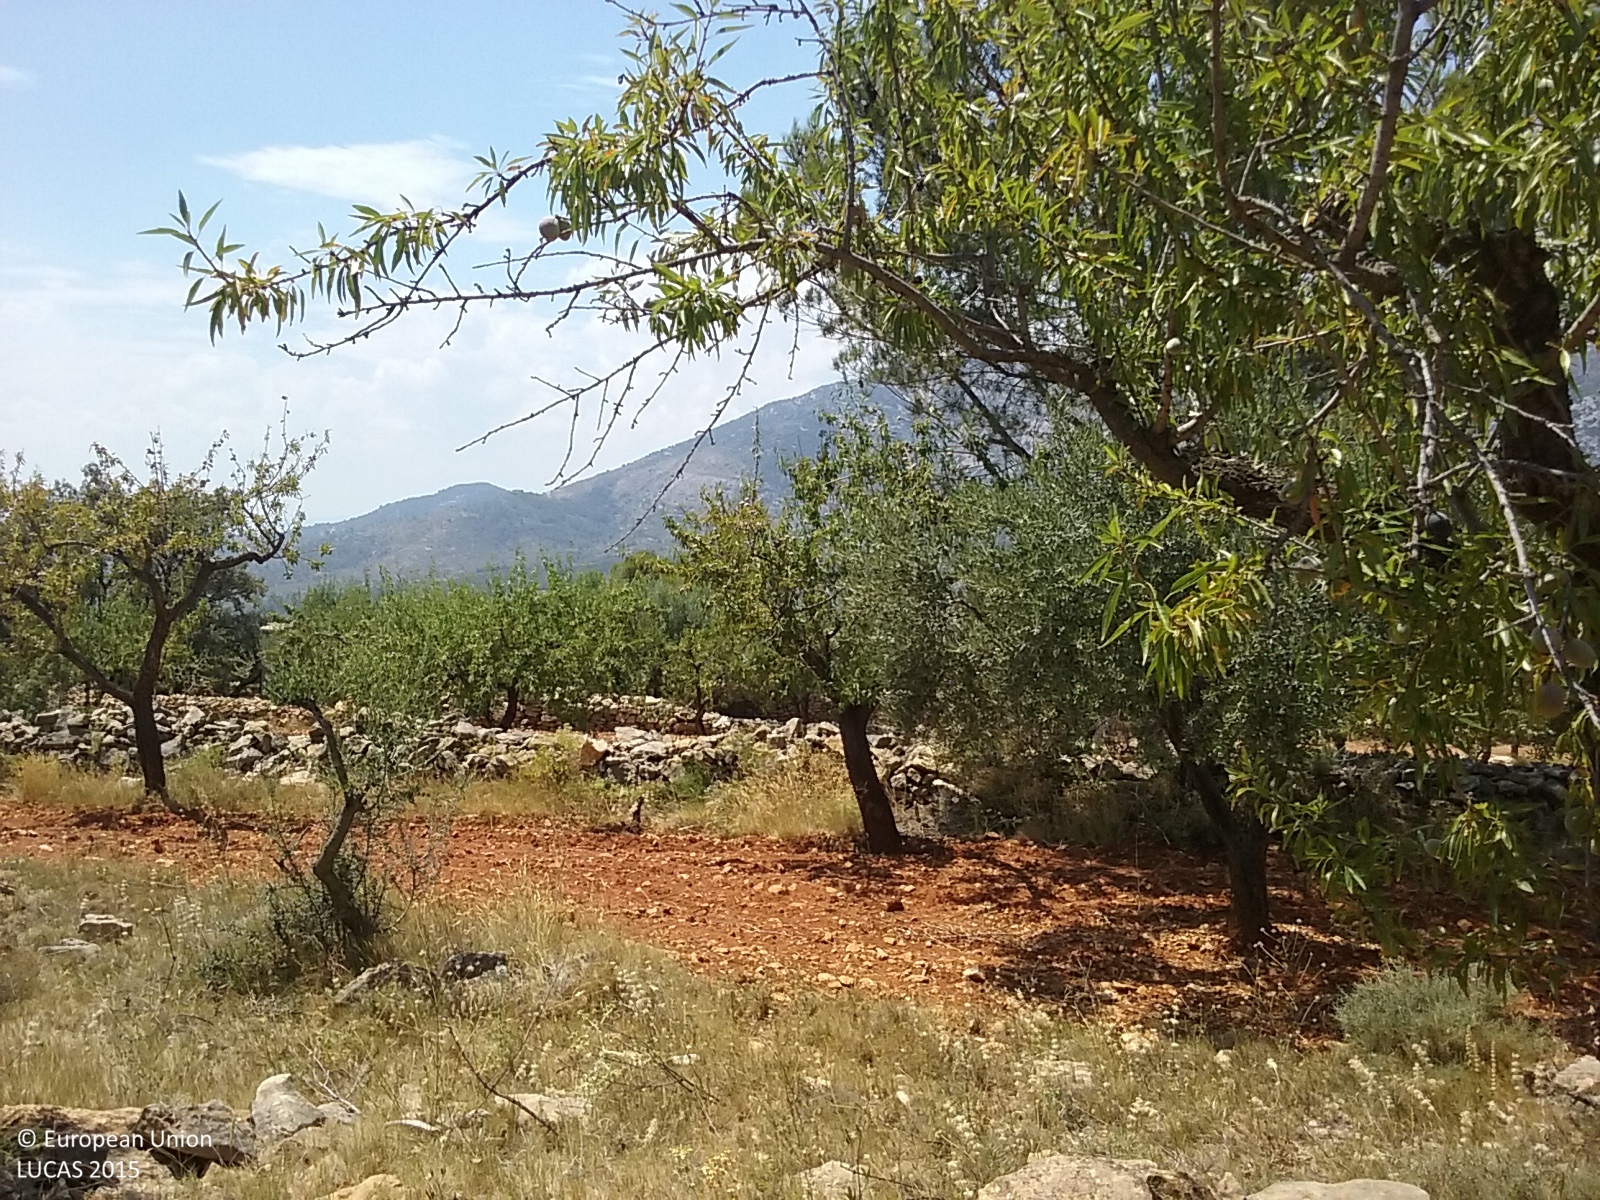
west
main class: Cropland
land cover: Nuts trees
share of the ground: 25 - 50 %
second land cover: Other bare soil
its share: > 75 %
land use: Agriculture (excluding fallow land and kitchen gardens)
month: July
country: ES
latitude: 40.2976
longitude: -0.0391
